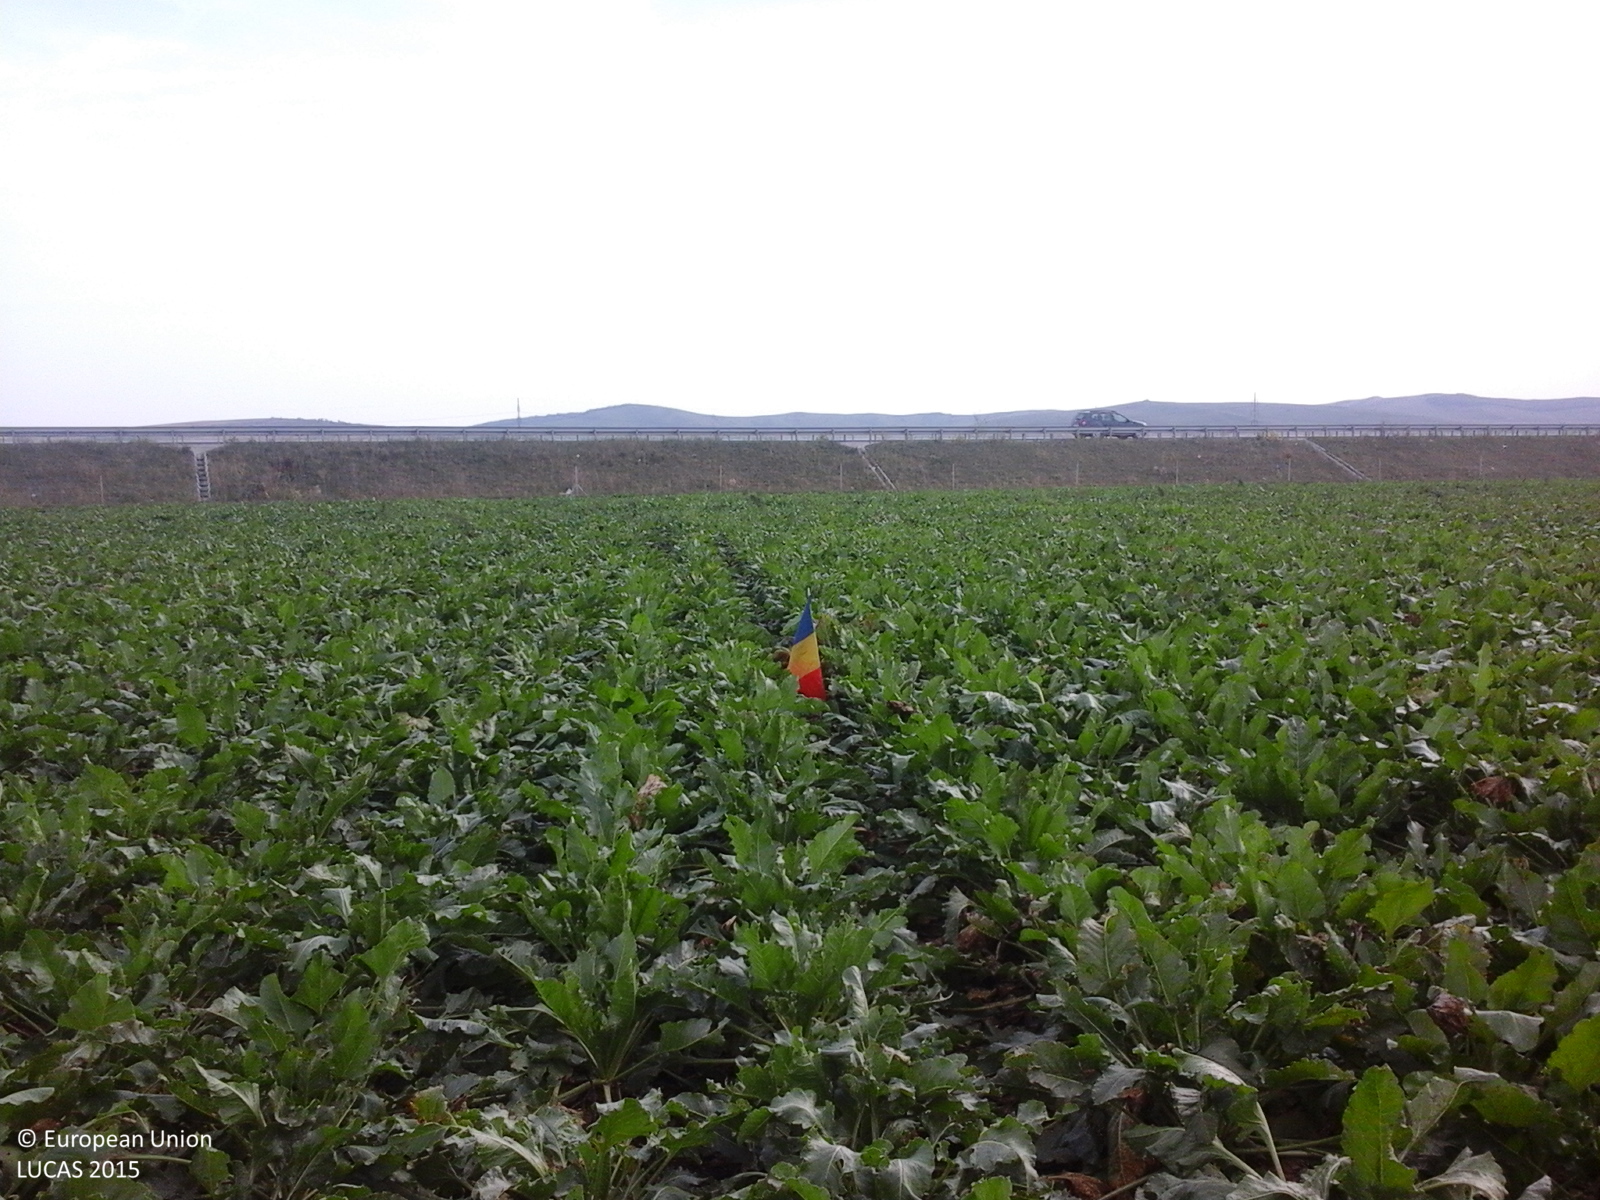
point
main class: Cropland
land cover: Other root crops
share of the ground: > 75 %
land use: Agriculture (excluding fallow land and kitchen gardens)
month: September
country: RO
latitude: 46.5254
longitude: 23.8271
